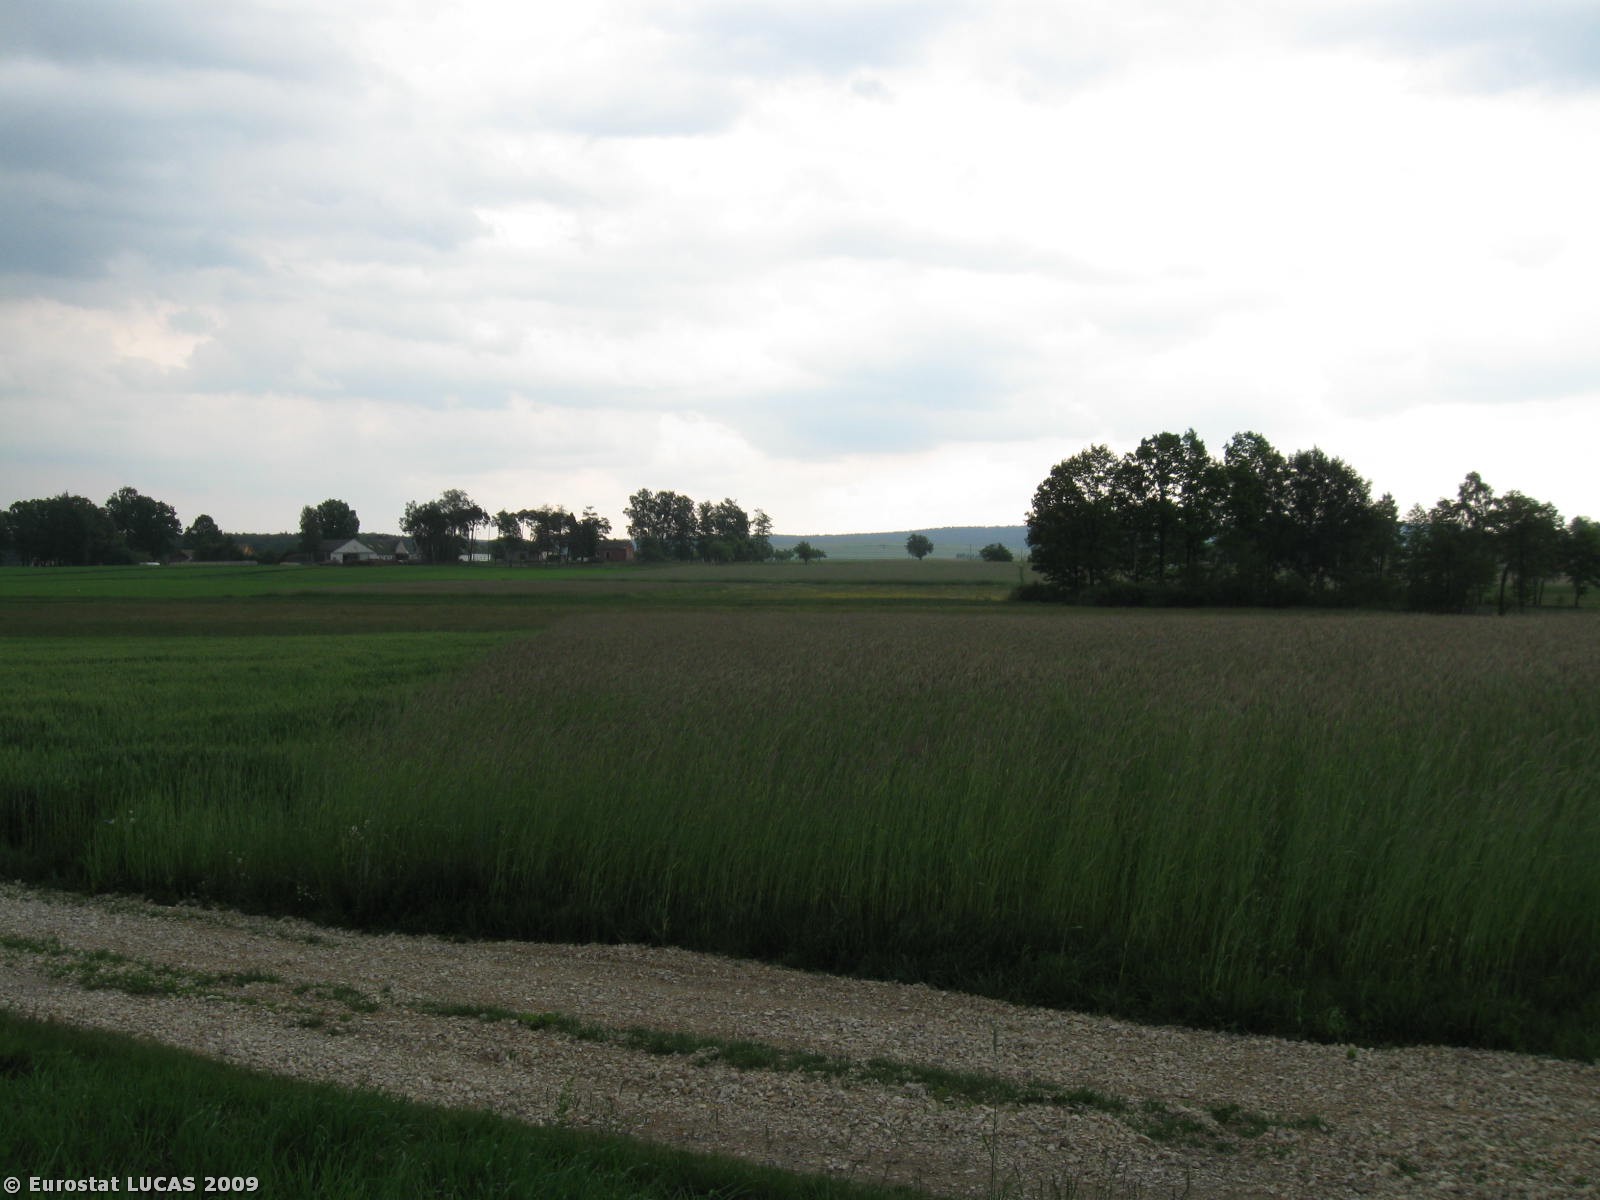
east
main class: Cropland
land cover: Oats
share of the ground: > 75 %
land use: Agriculture (excluding fallow land and kitchen gardens)
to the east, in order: Oats; Paved roads, cycling and walking lanes; Rye; Grassland without tree/shrub cover; Groves; Grassland without tree/shrub cover
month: May
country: PL
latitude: 50.9925
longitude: 20.2221
